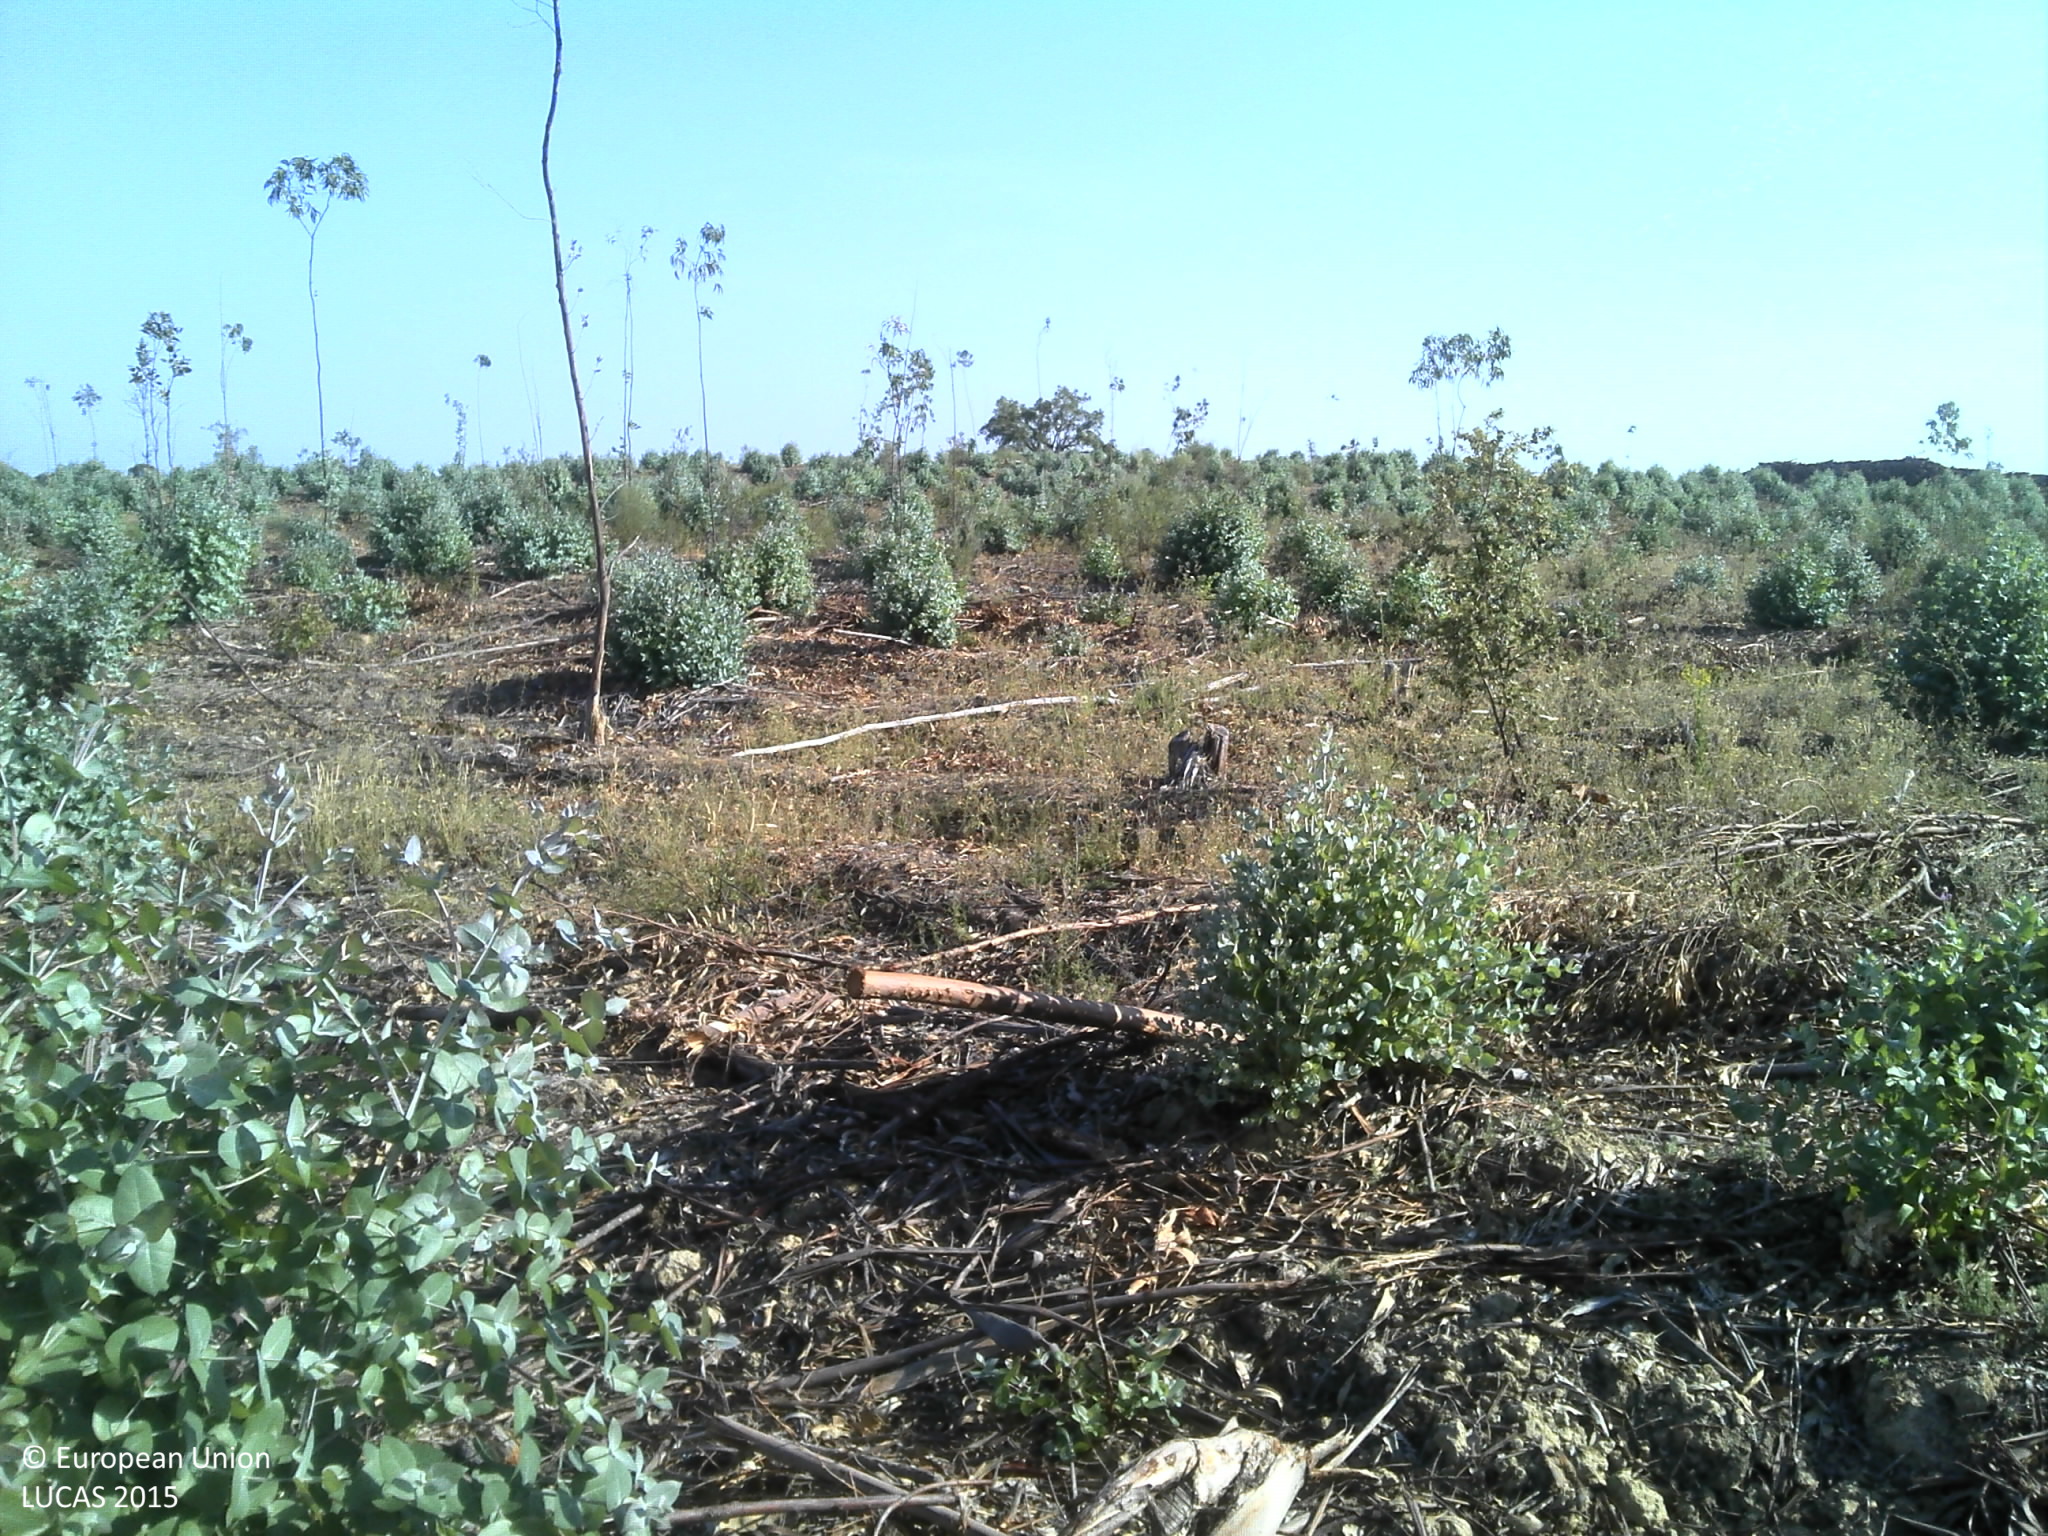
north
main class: Woodland
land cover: Broadleaved woodland
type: exotic forest
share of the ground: 25 - 50 %
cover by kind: unconsolidated bare surface 65 %, broadleaved forest trees 25 %, shrubs 10 %
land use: Forestry
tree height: < 5 m
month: June
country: PT
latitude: 39.9267
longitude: -7.1405
